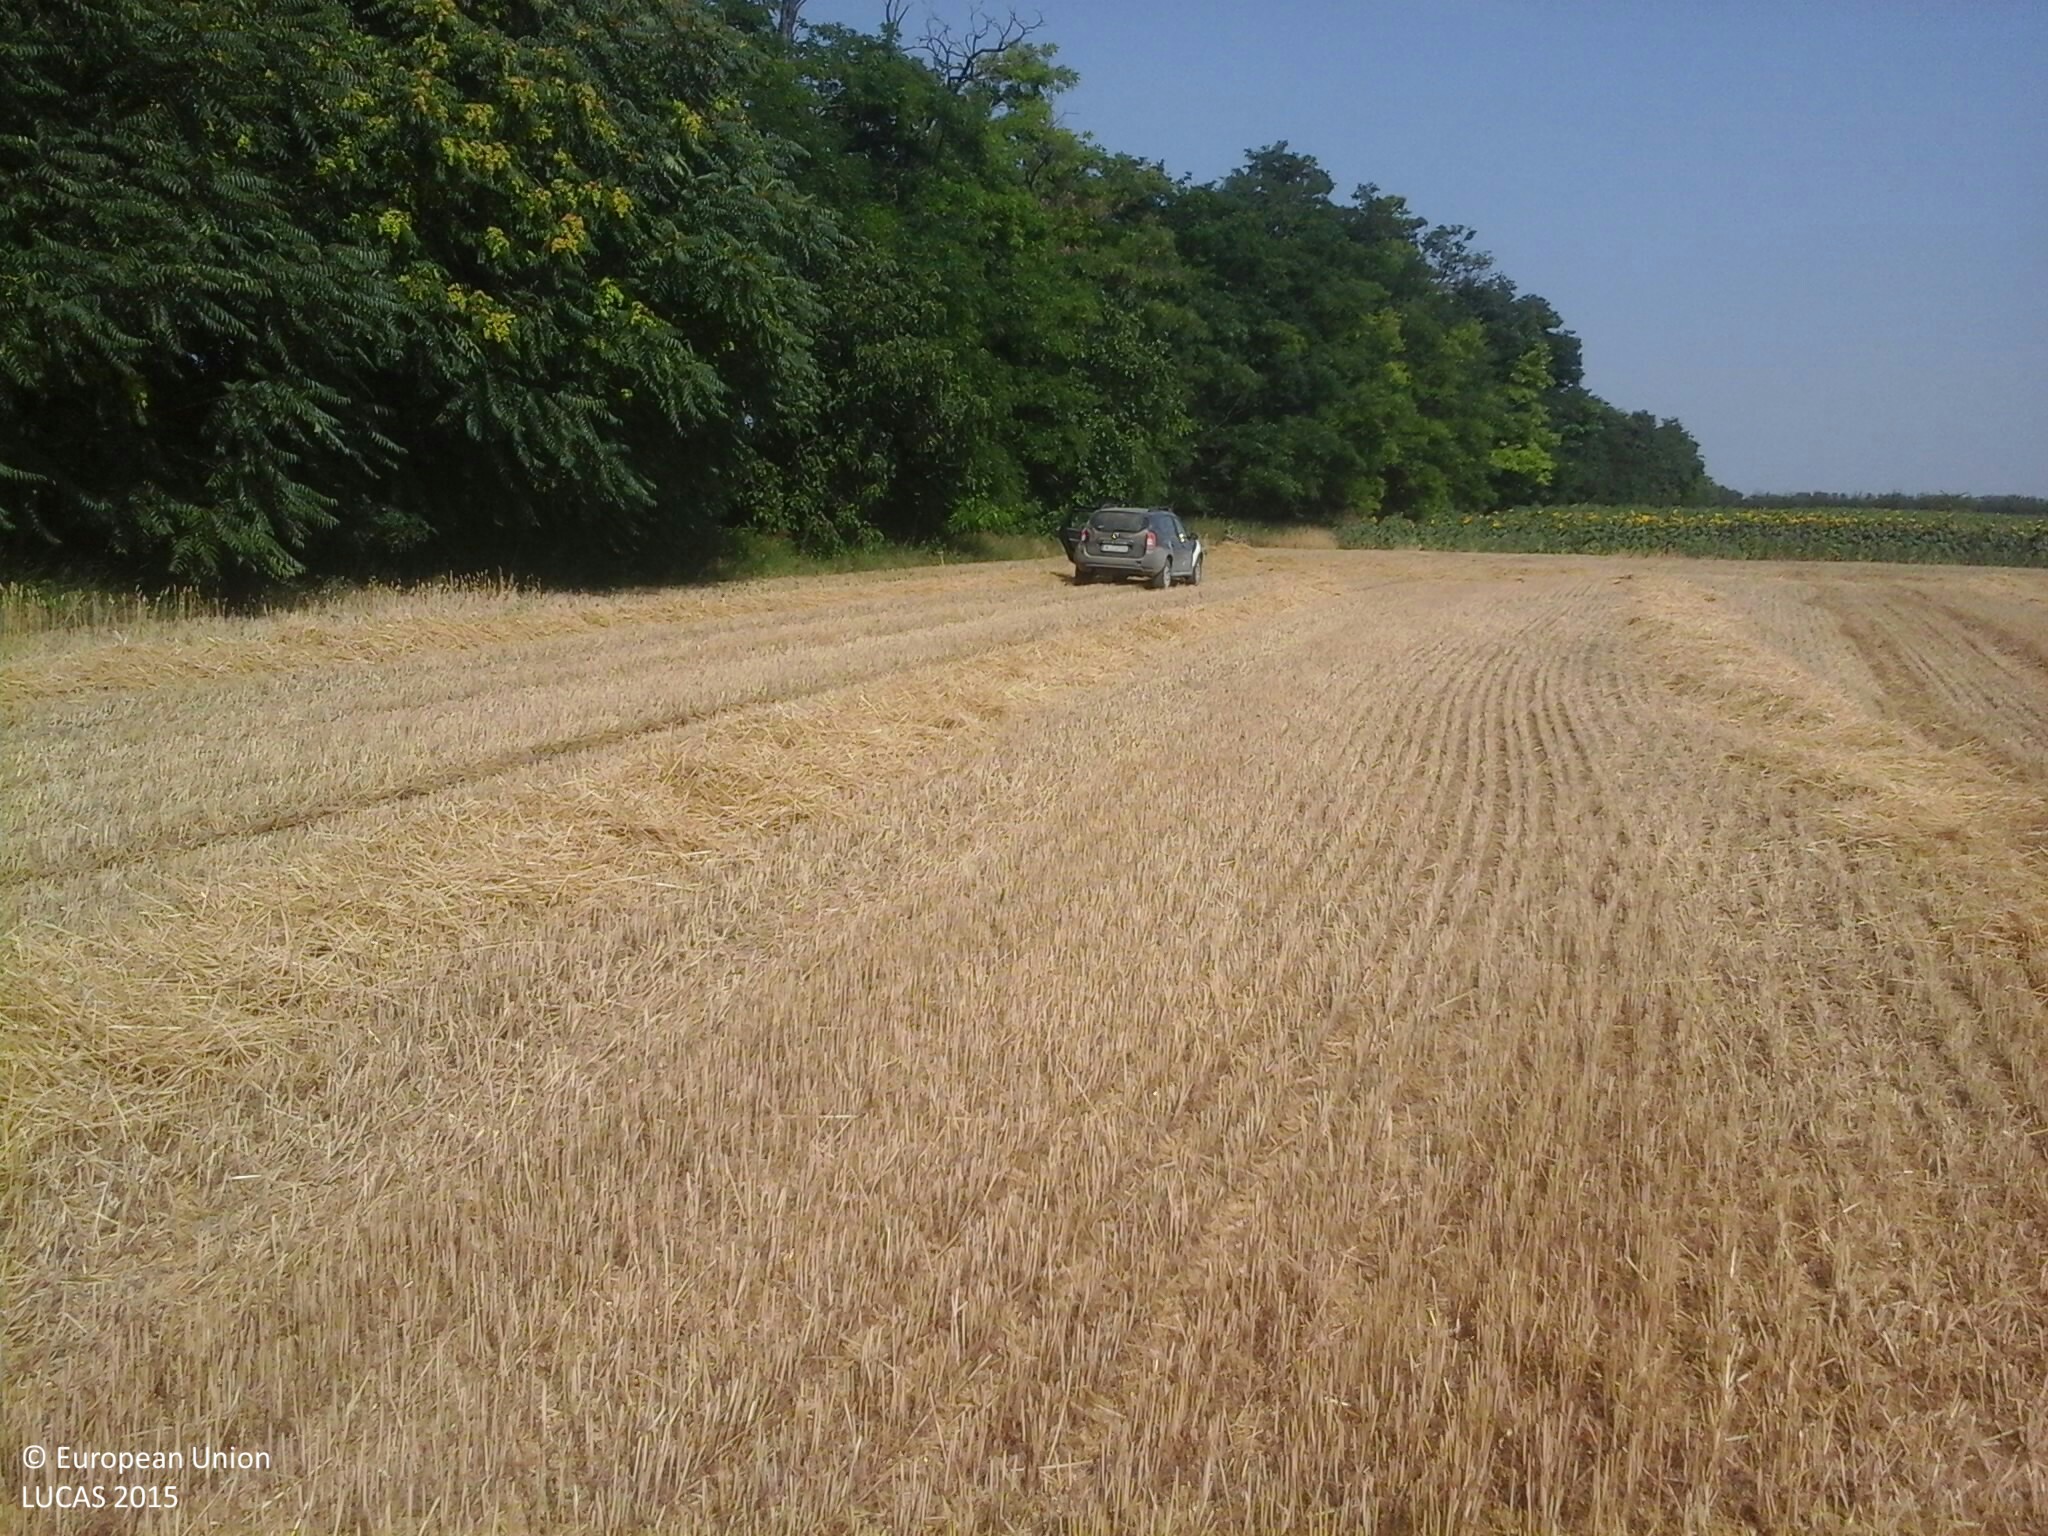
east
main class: Cropland
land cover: Common wheat
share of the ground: > 75 %
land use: Agriculture (excluding fallow land and kitchen gardens)
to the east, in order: Common wheat; Broadleaved woodland; Sunflower
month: July
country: HU
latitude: 47.2225
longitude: 18.9831
